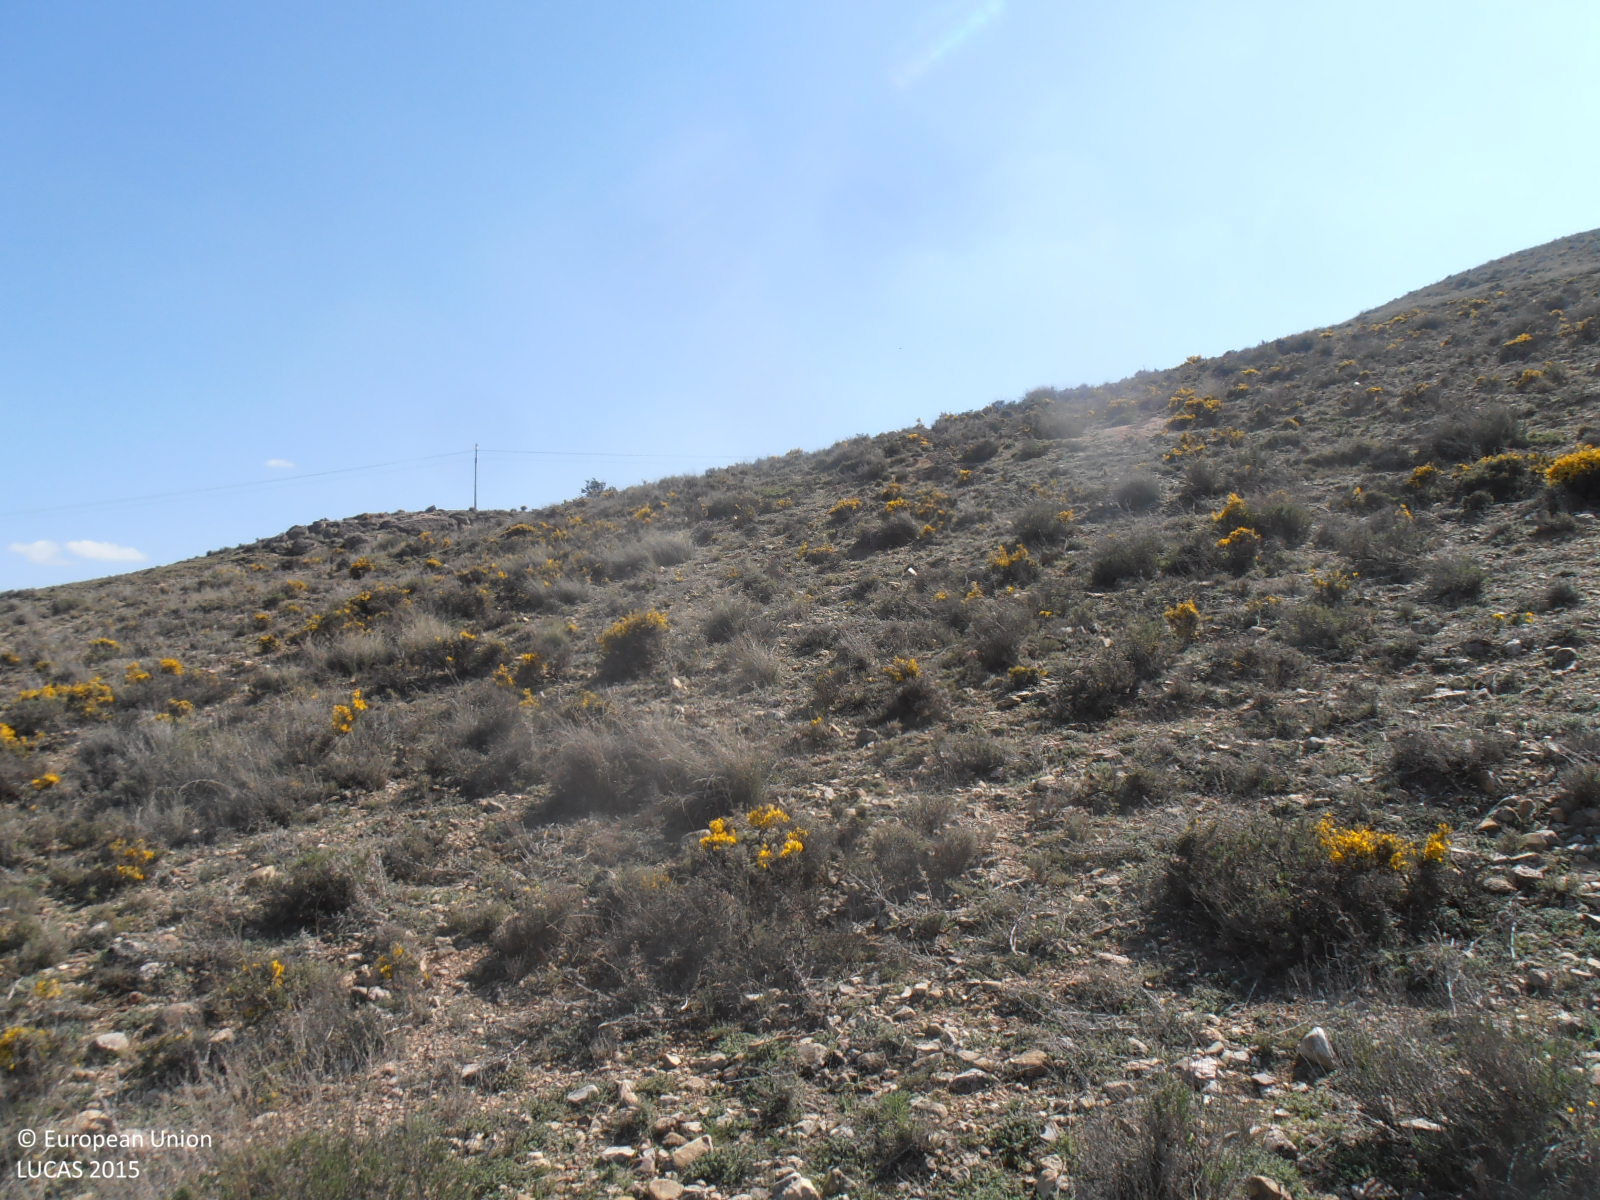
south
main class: Shrubland
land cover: Shrubland without tree cover
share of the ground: 25 - 50 %
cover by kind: unconsolidated bare surface 55 %, shrubs 45 %
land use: Semi-natural and natural areas not in use
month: April
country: ES
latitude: 41.5415
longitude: -1.0140
